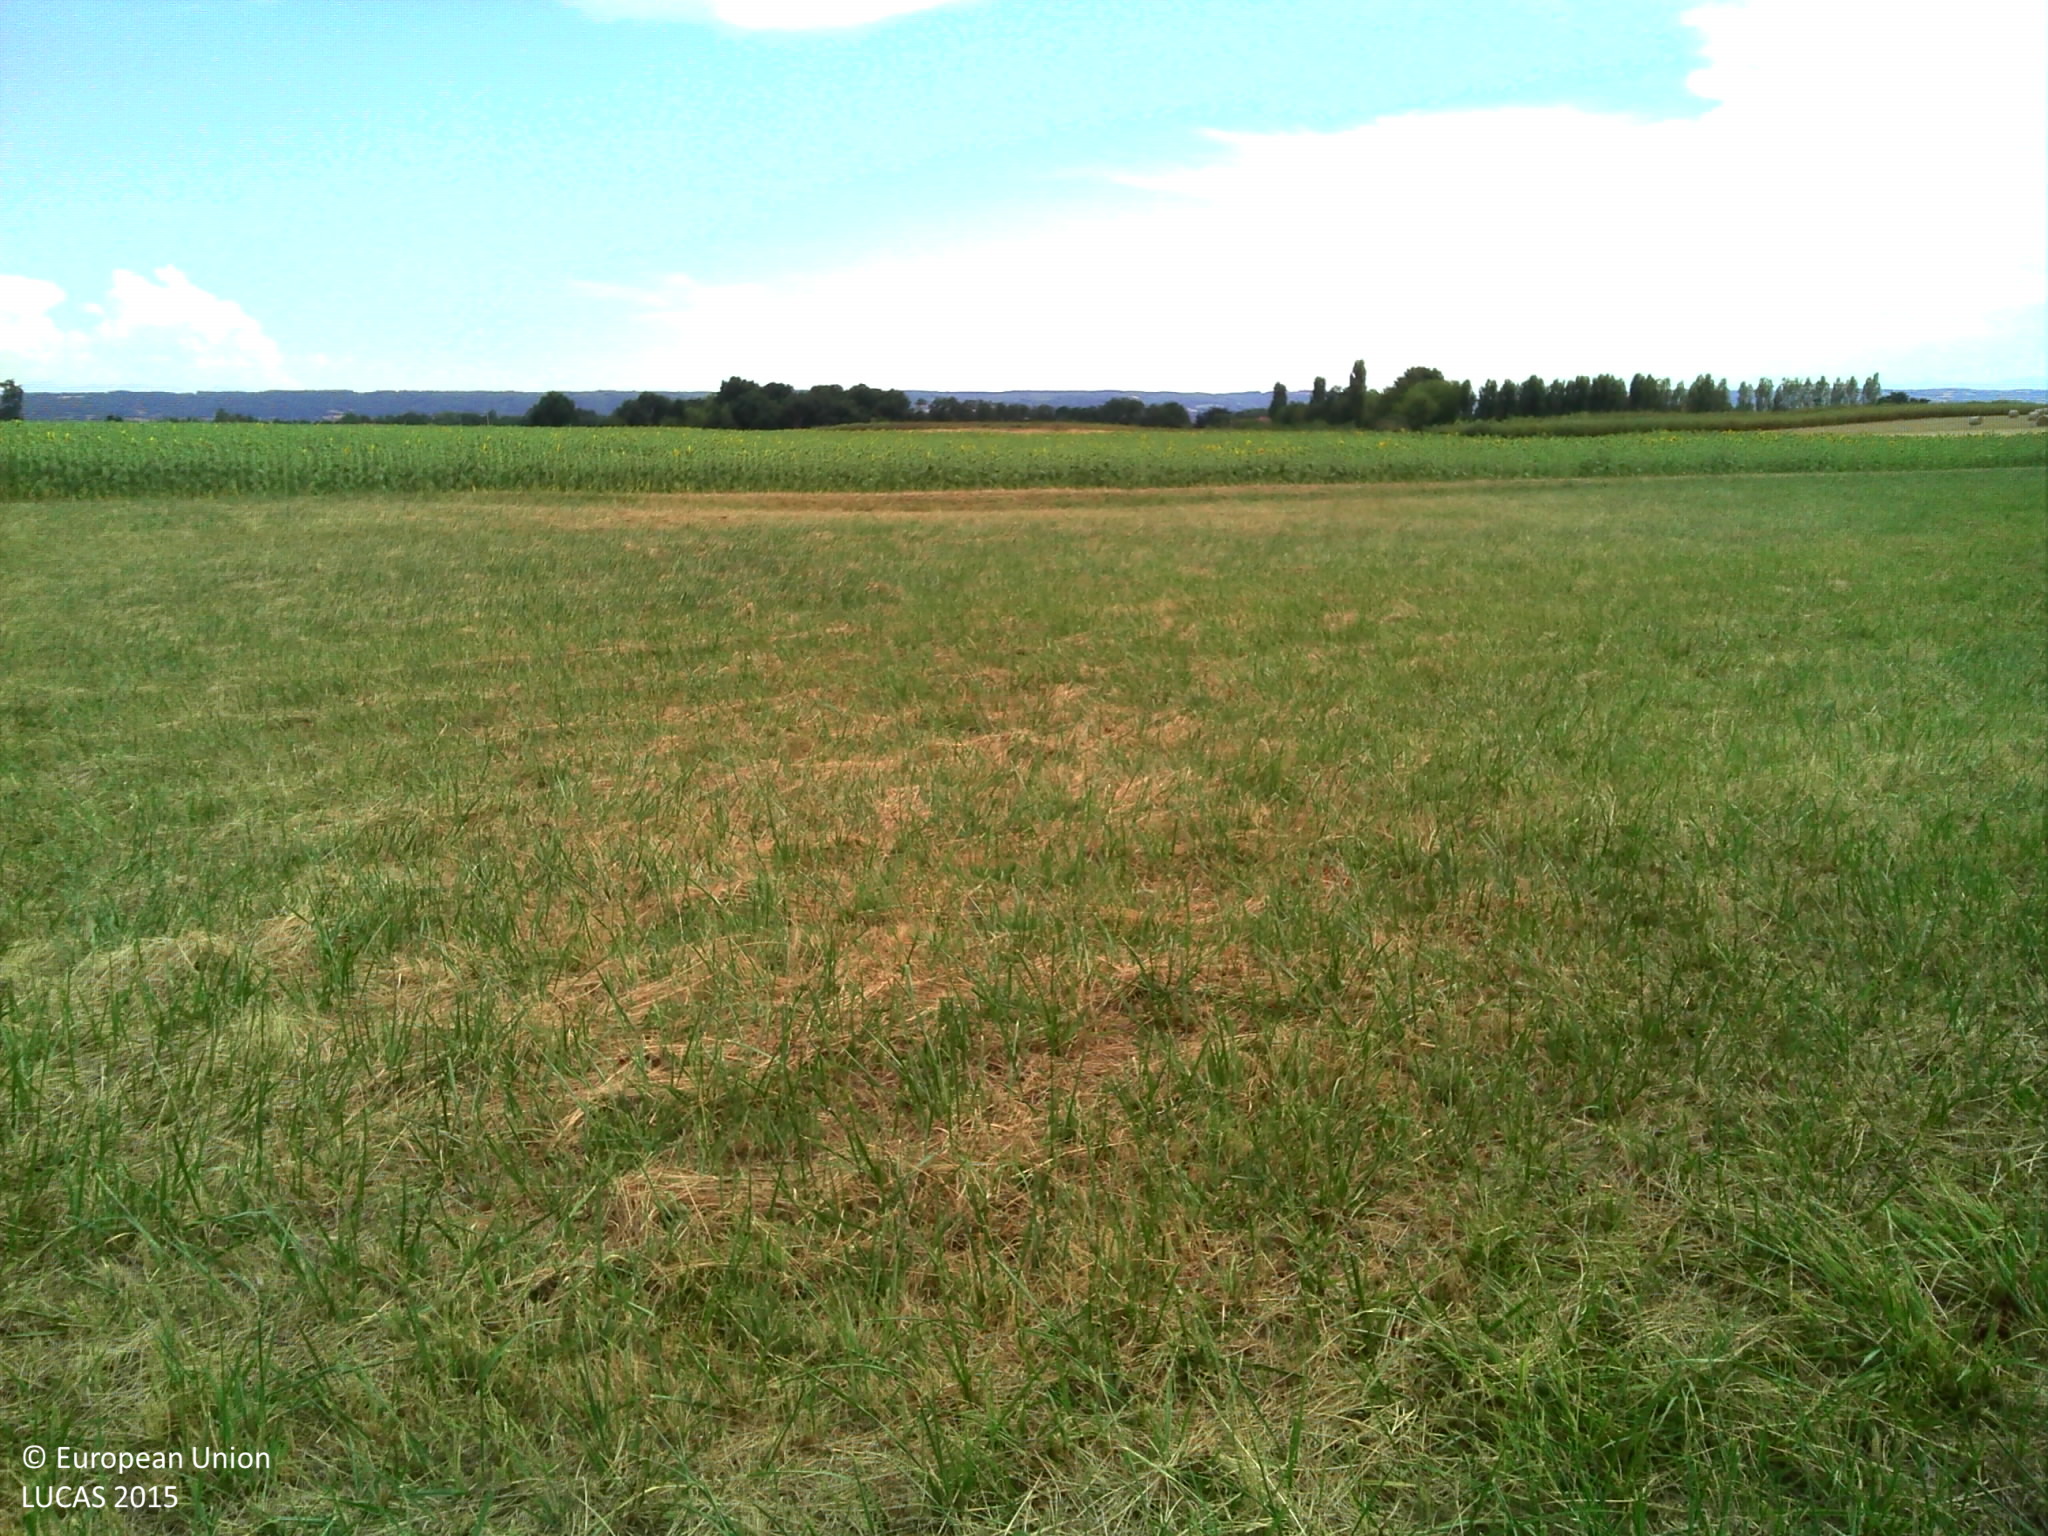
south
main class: Cropland
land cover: Temporary grasslands
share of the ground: > 75 %
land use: Agriculture (excluding fallow land and kitchen gardens)
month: July
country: FR
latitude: 45.3685
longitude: 5.0124
